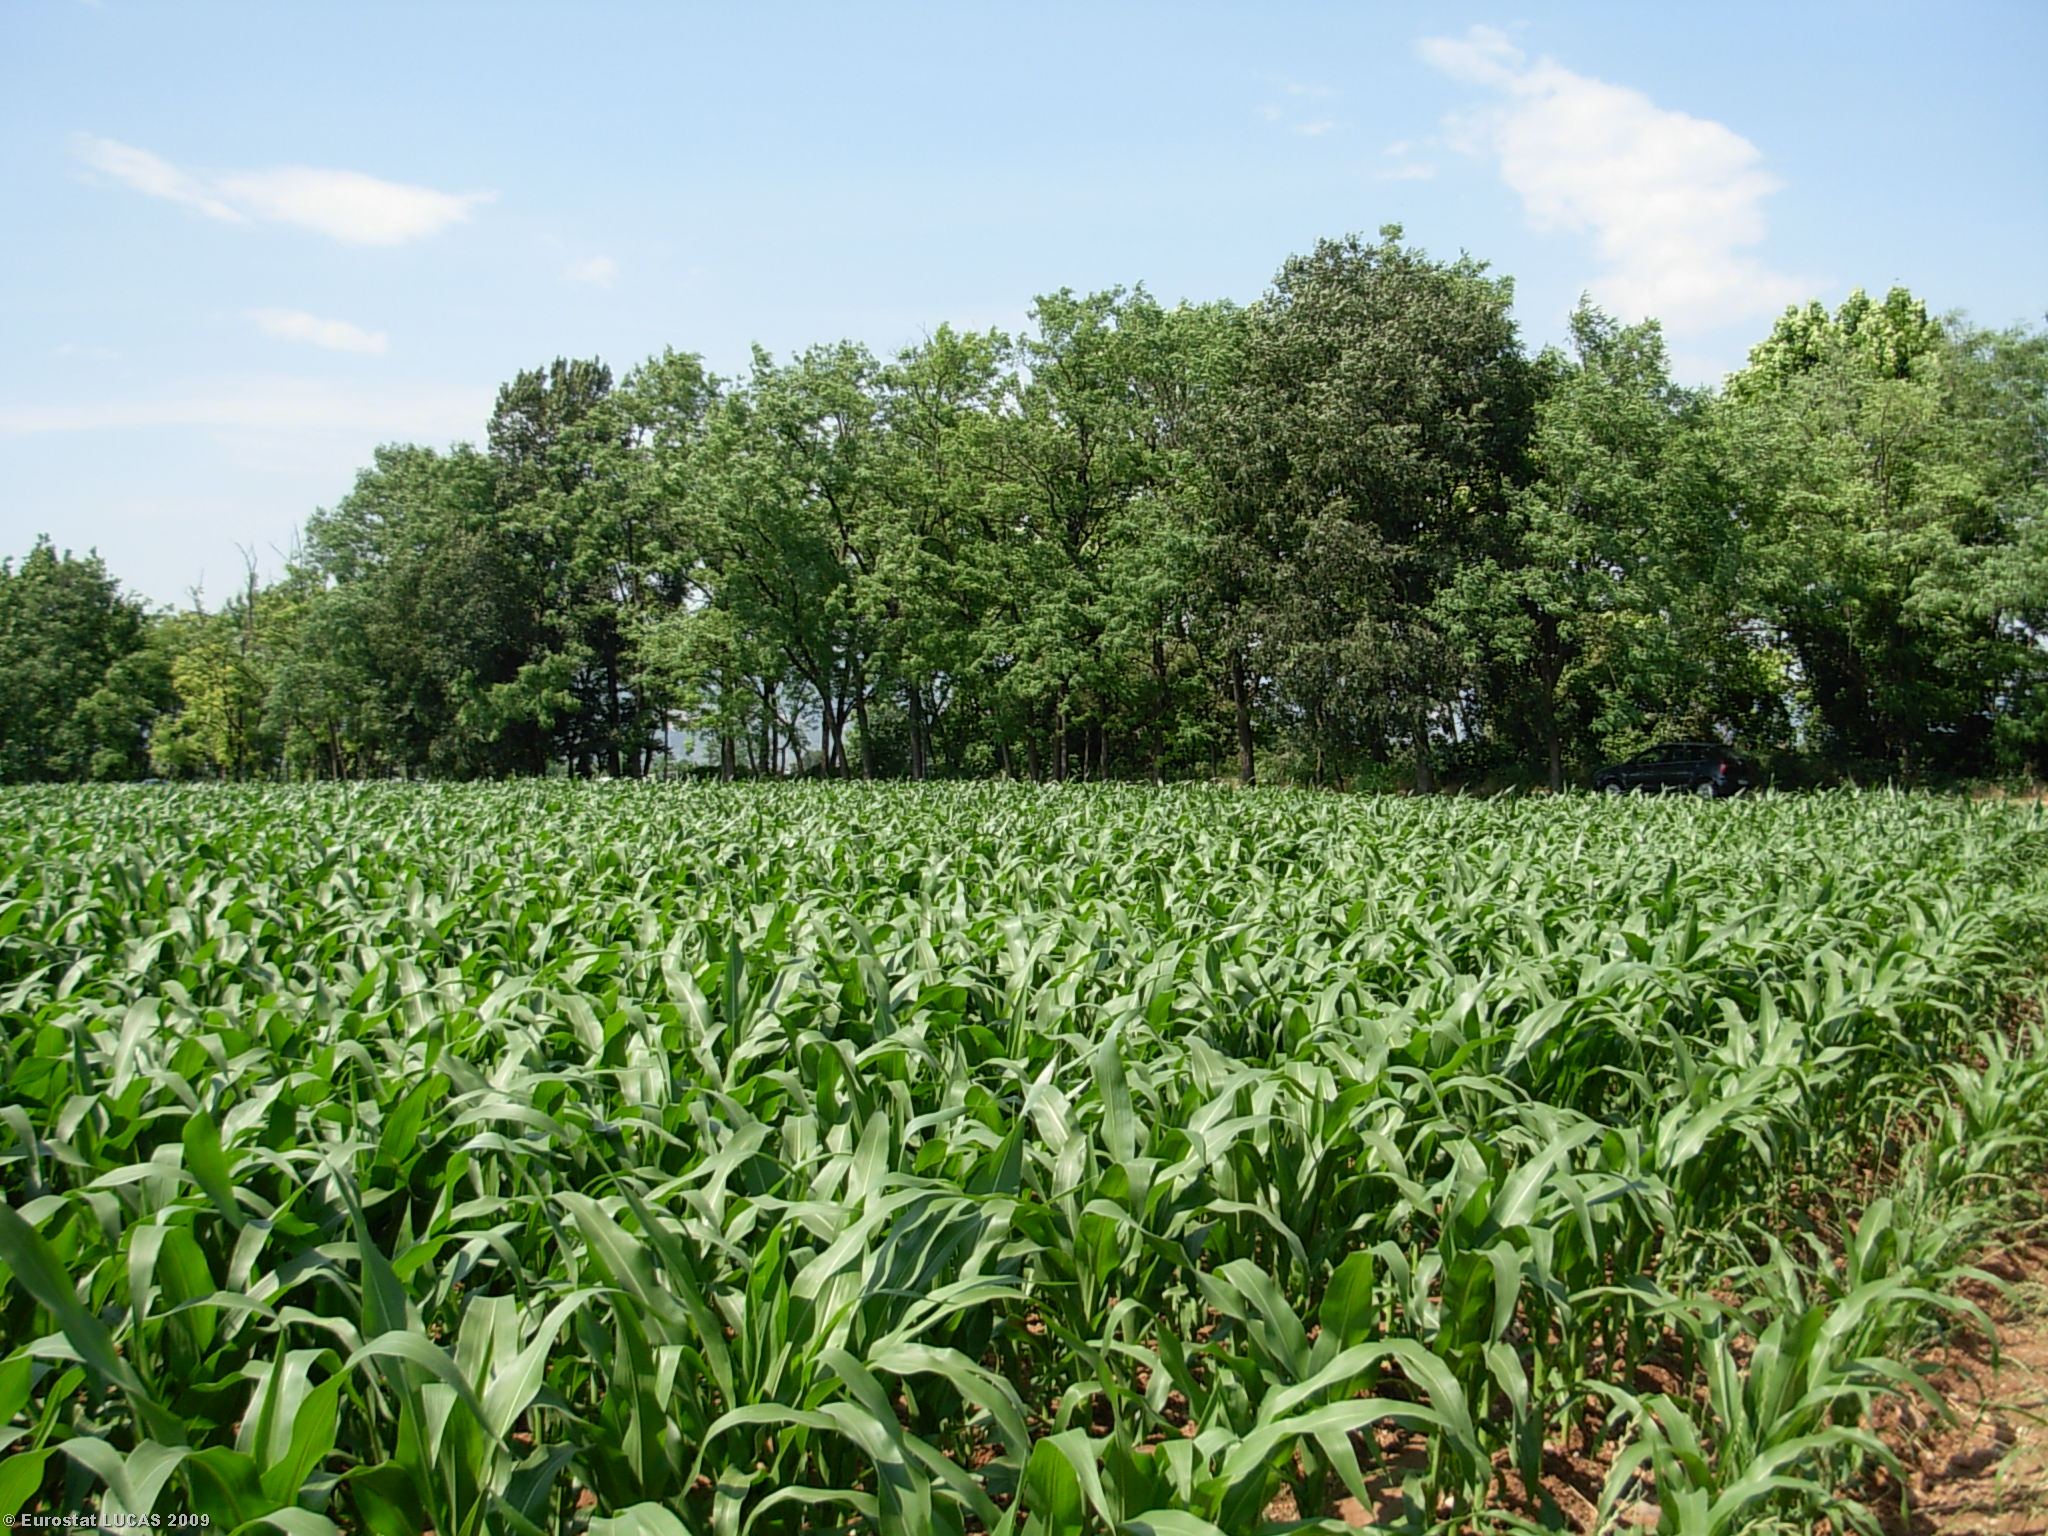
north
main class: Cropland
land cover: Maize
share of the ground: > 75 %
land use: Agriculture (excluding fallow land and kitchen gardens)
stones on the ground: 25 - 50 %
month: June
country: IT
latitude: 45.4677
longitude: 10.3703
